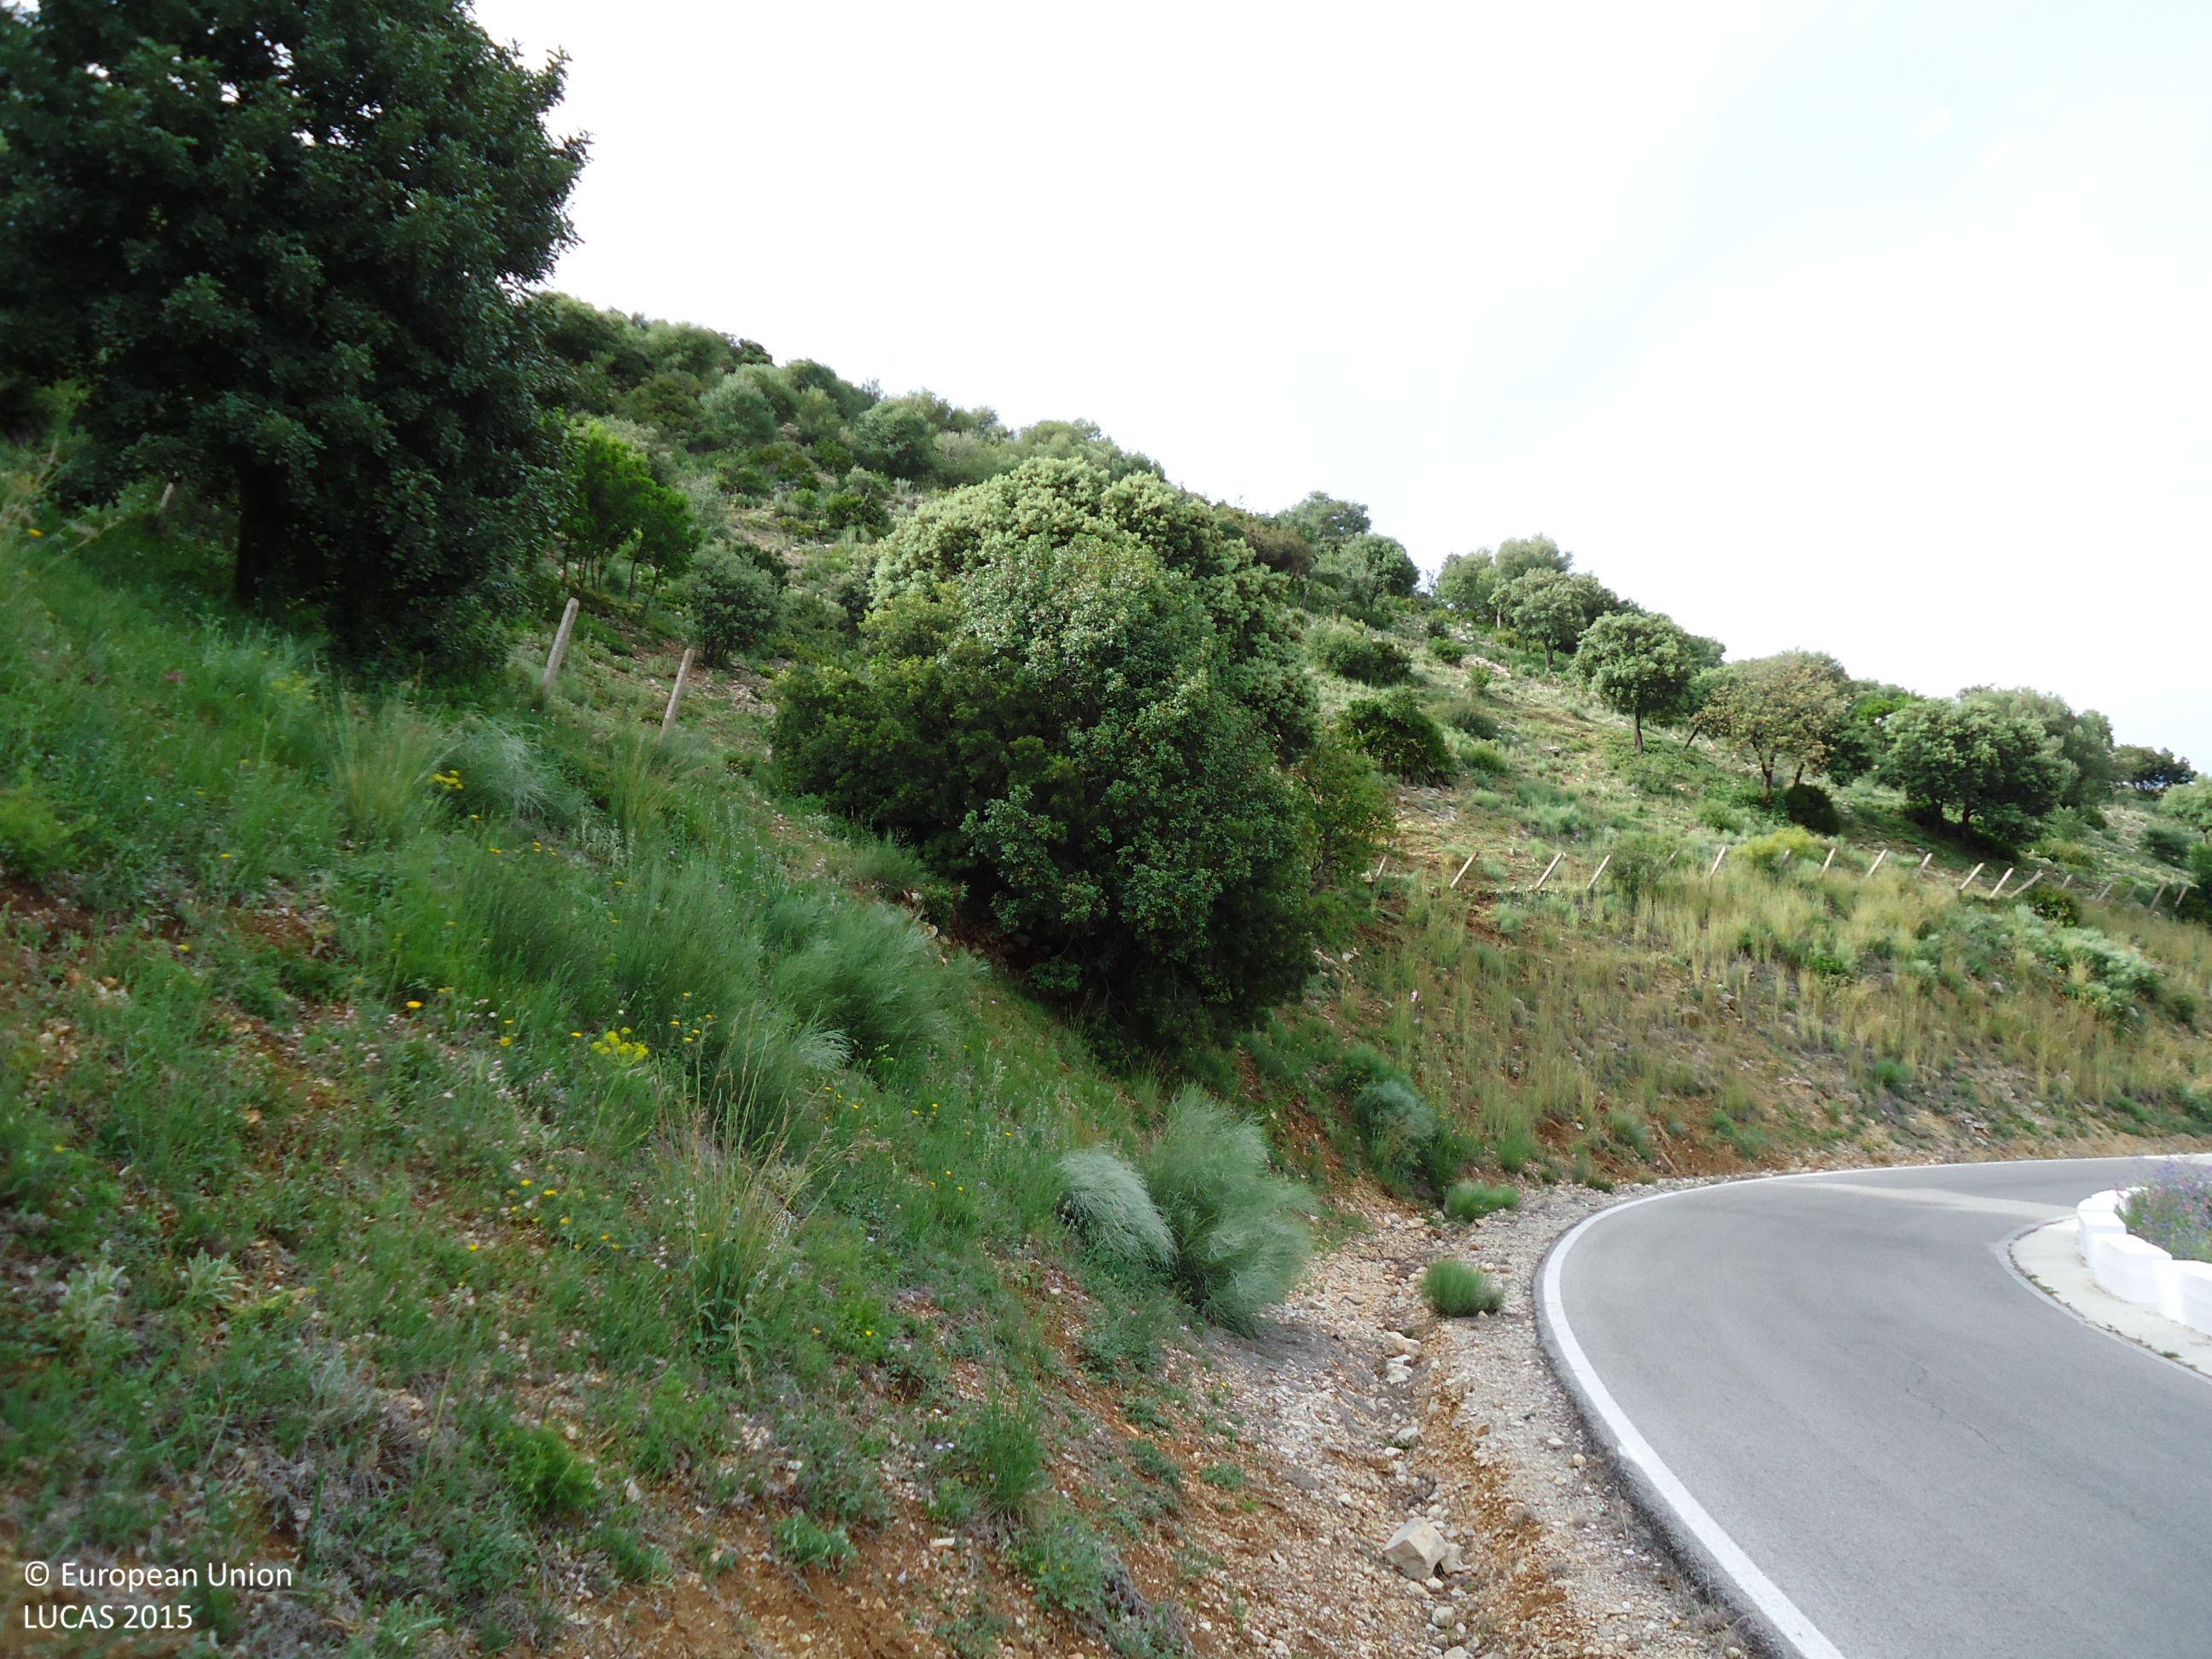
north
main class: Woodland
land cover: Broadleaved woodland
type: broadleaved evergreen forest
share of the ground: 10 - 25 %
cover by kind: herbaceous plants 75 %, broadleaved forest trees 20 %, shrubs 5 %
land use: Forestry
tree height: > 5 m
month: May
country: ES
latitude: 36.8173
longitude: -5.3954
